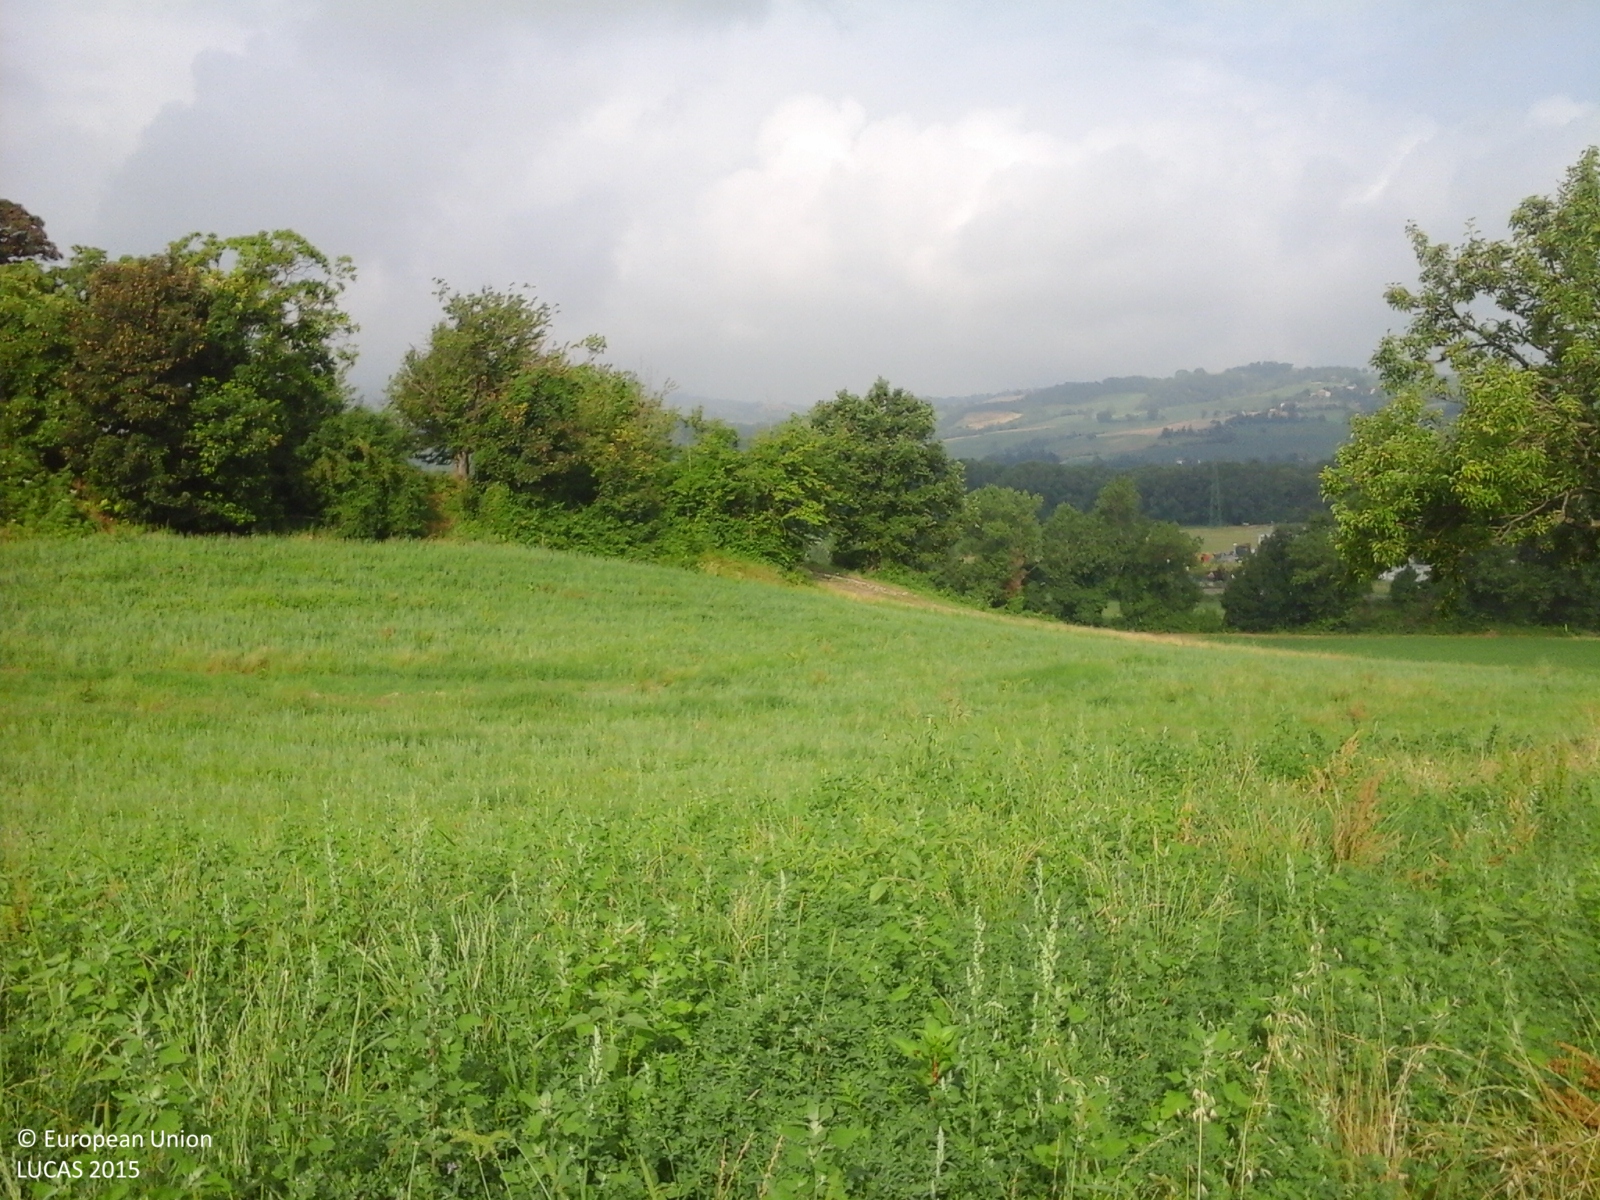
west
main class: Cropland
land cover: Lucerne
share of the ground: > 75 %
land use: Agriculture (excluding fallow land and kitchen gardens)
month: June
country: IT
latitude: 44.6387
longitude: 10.2893
